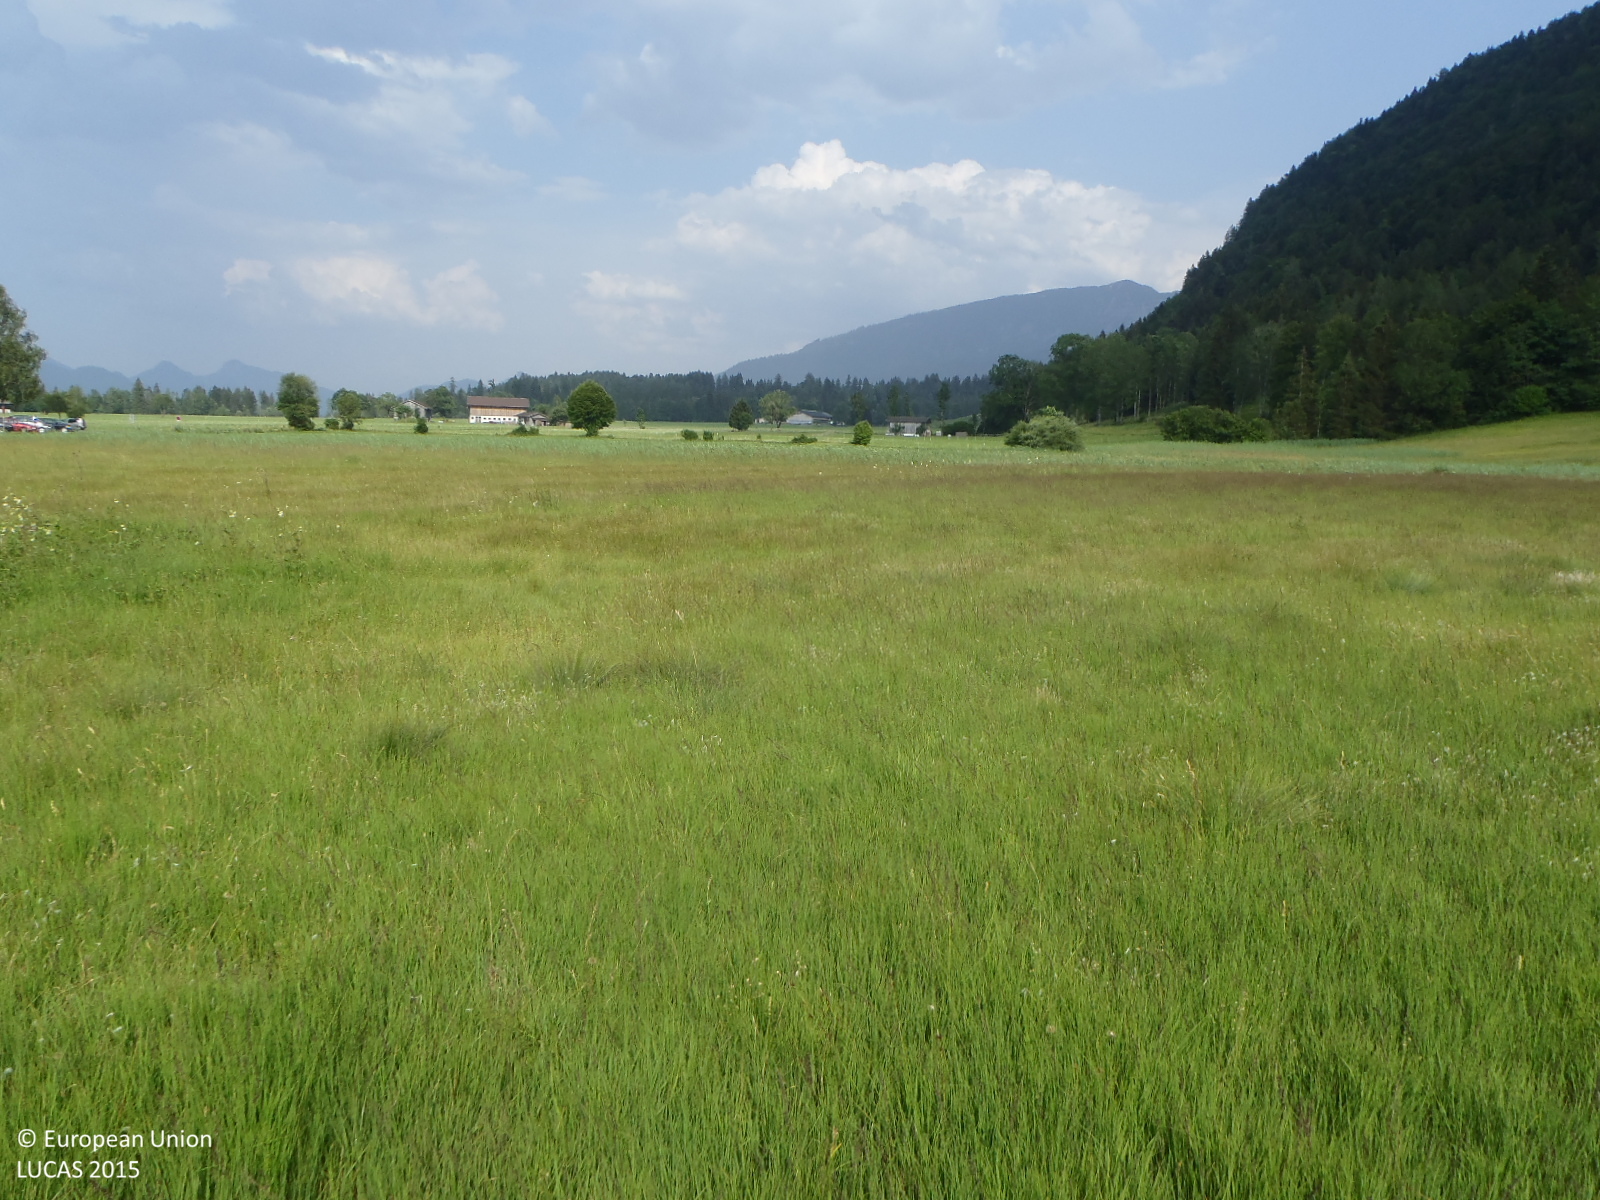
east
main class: Grassland
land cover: Grassland without tree/shrub cover
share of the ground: > 75 %
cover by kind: herbaceous plants 70 %, lichens and mosses 30 %
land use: Agriculture (excluding fallow land and kitchen gardens)
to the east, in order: Grassland without tree/shrub cover; Ditches and canals; Grassland without tree/shrub cover; Ditches and canals; Grassland without tree/shrub cover
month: July
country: AT
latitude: 47.6408
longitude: 12.3279
